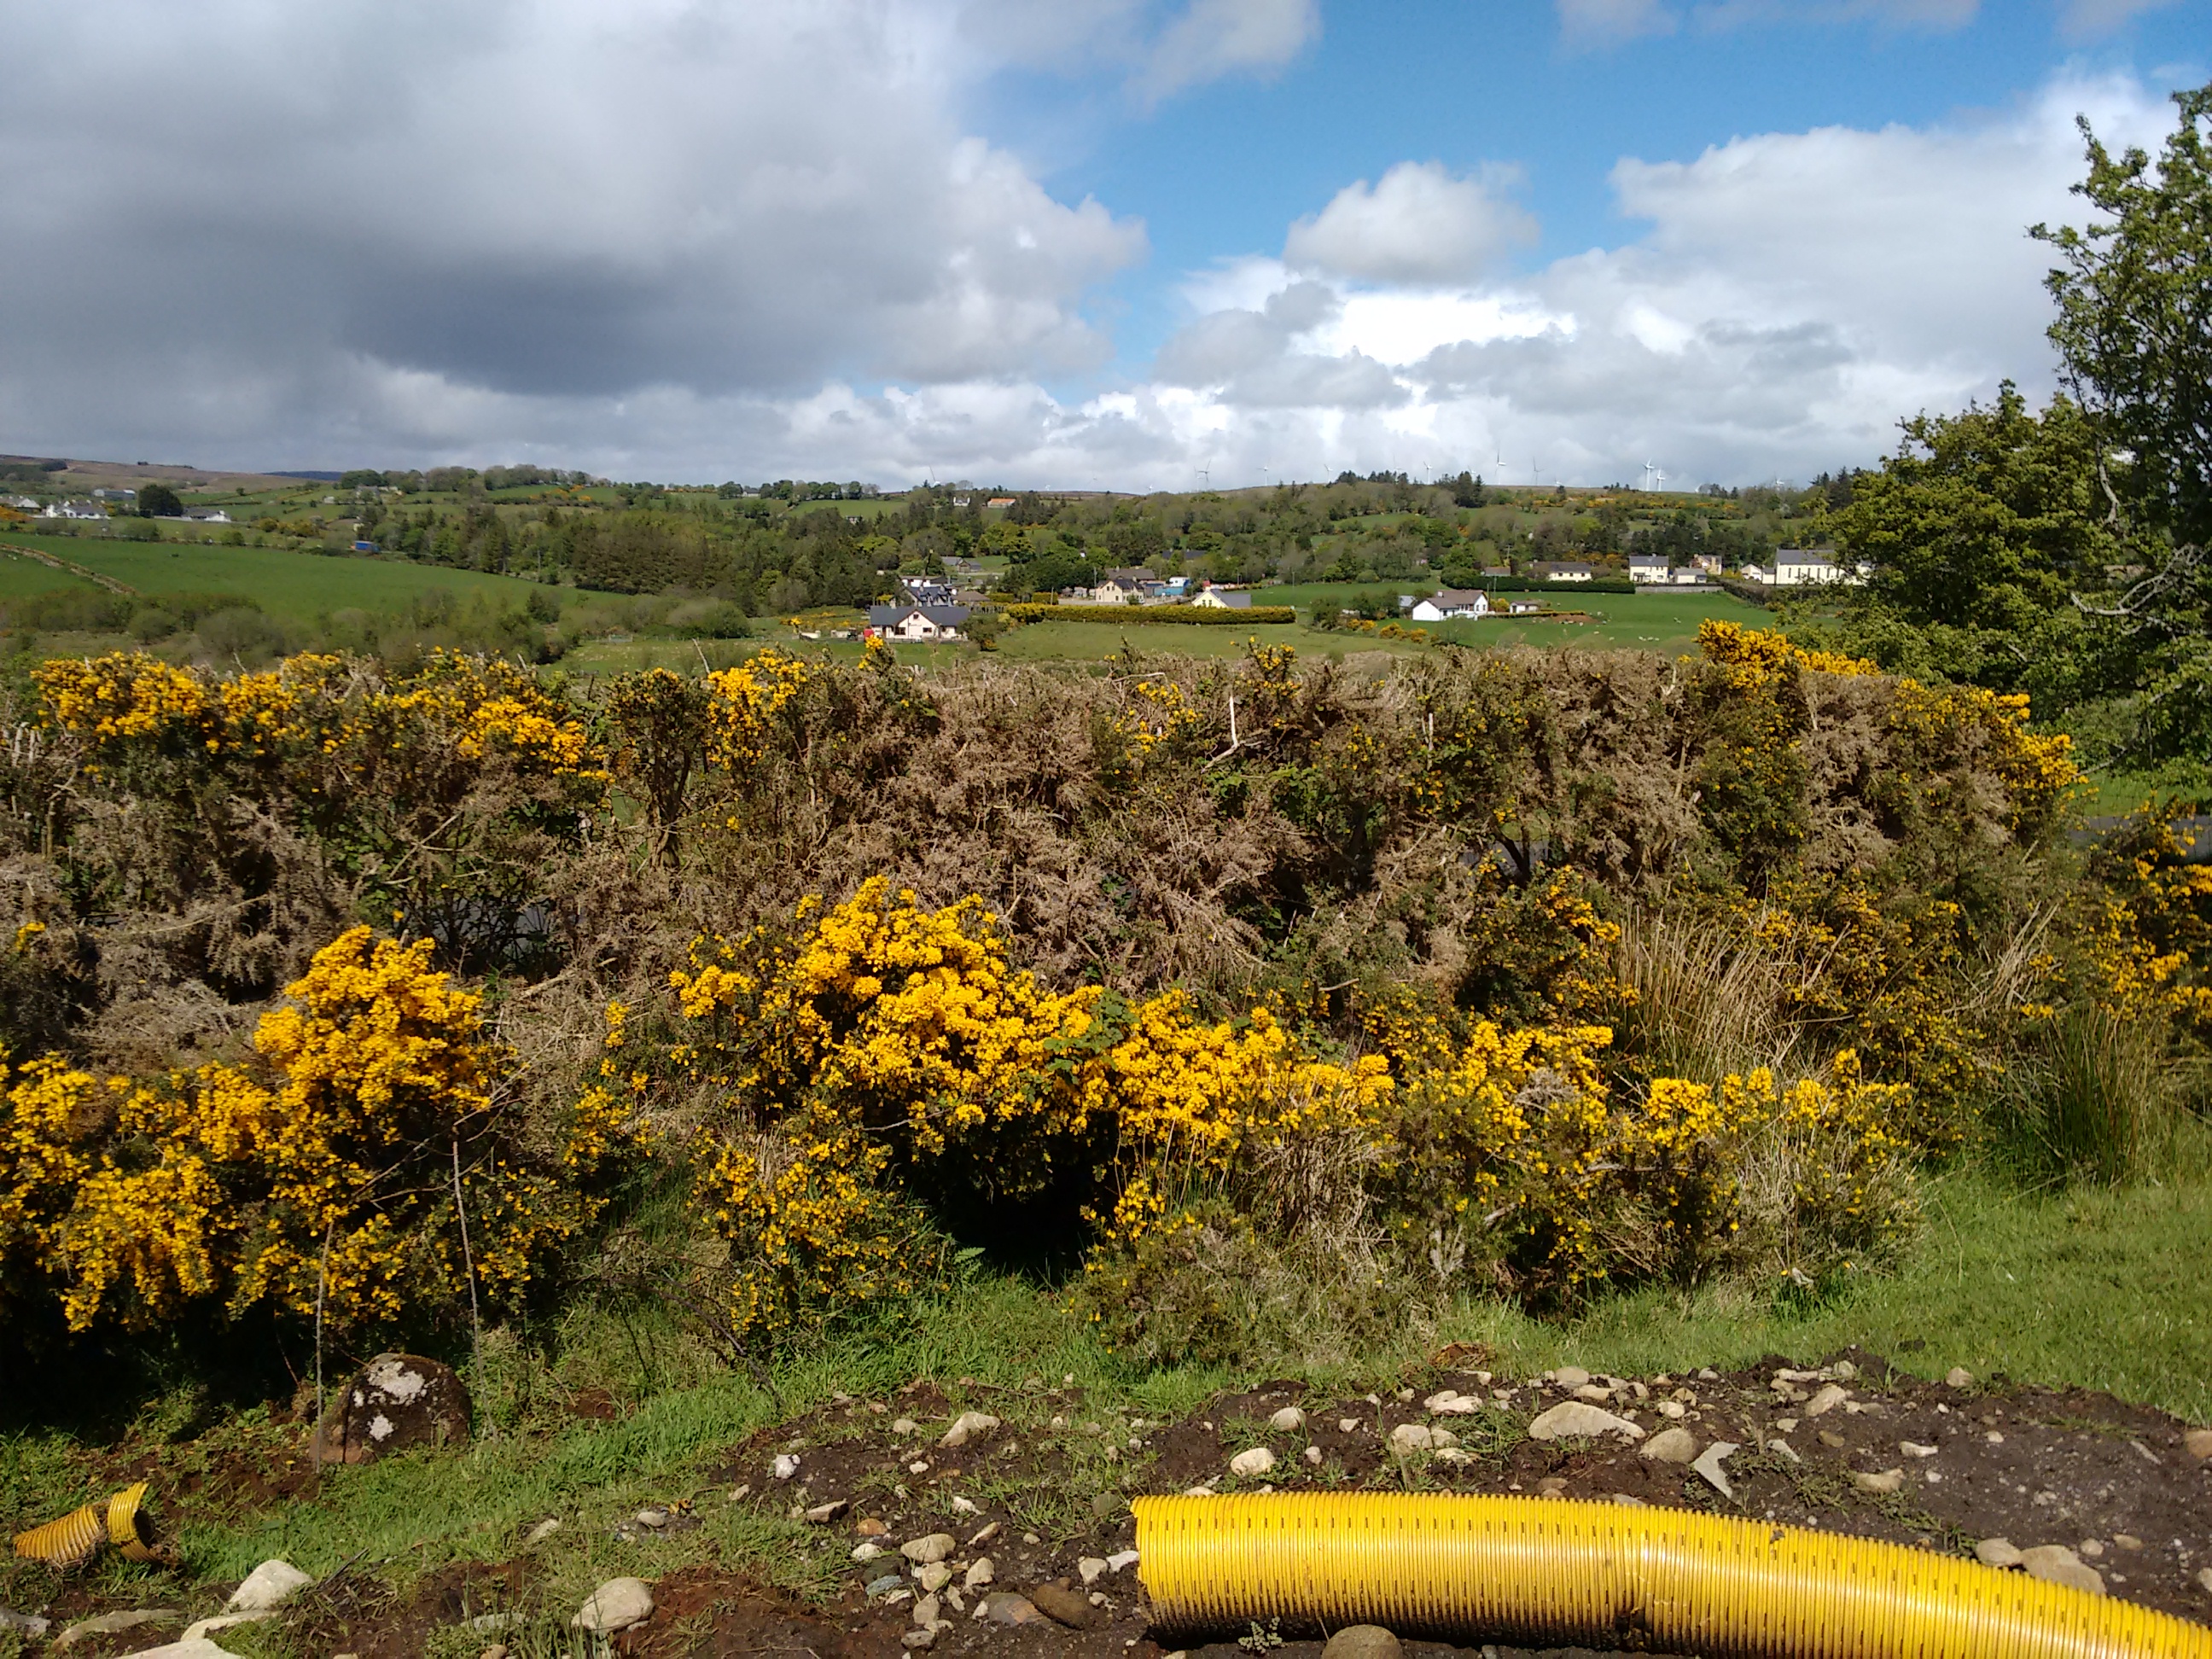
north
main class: Grassland
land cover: Grassland without tree/shrub cover
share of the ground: > 75 %
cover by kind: herbaceous plants 100 %
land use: Agriculture (excluding fallow land and kitchen gardens)
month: May
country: GB
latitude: 54.9246
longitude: -7.0382
